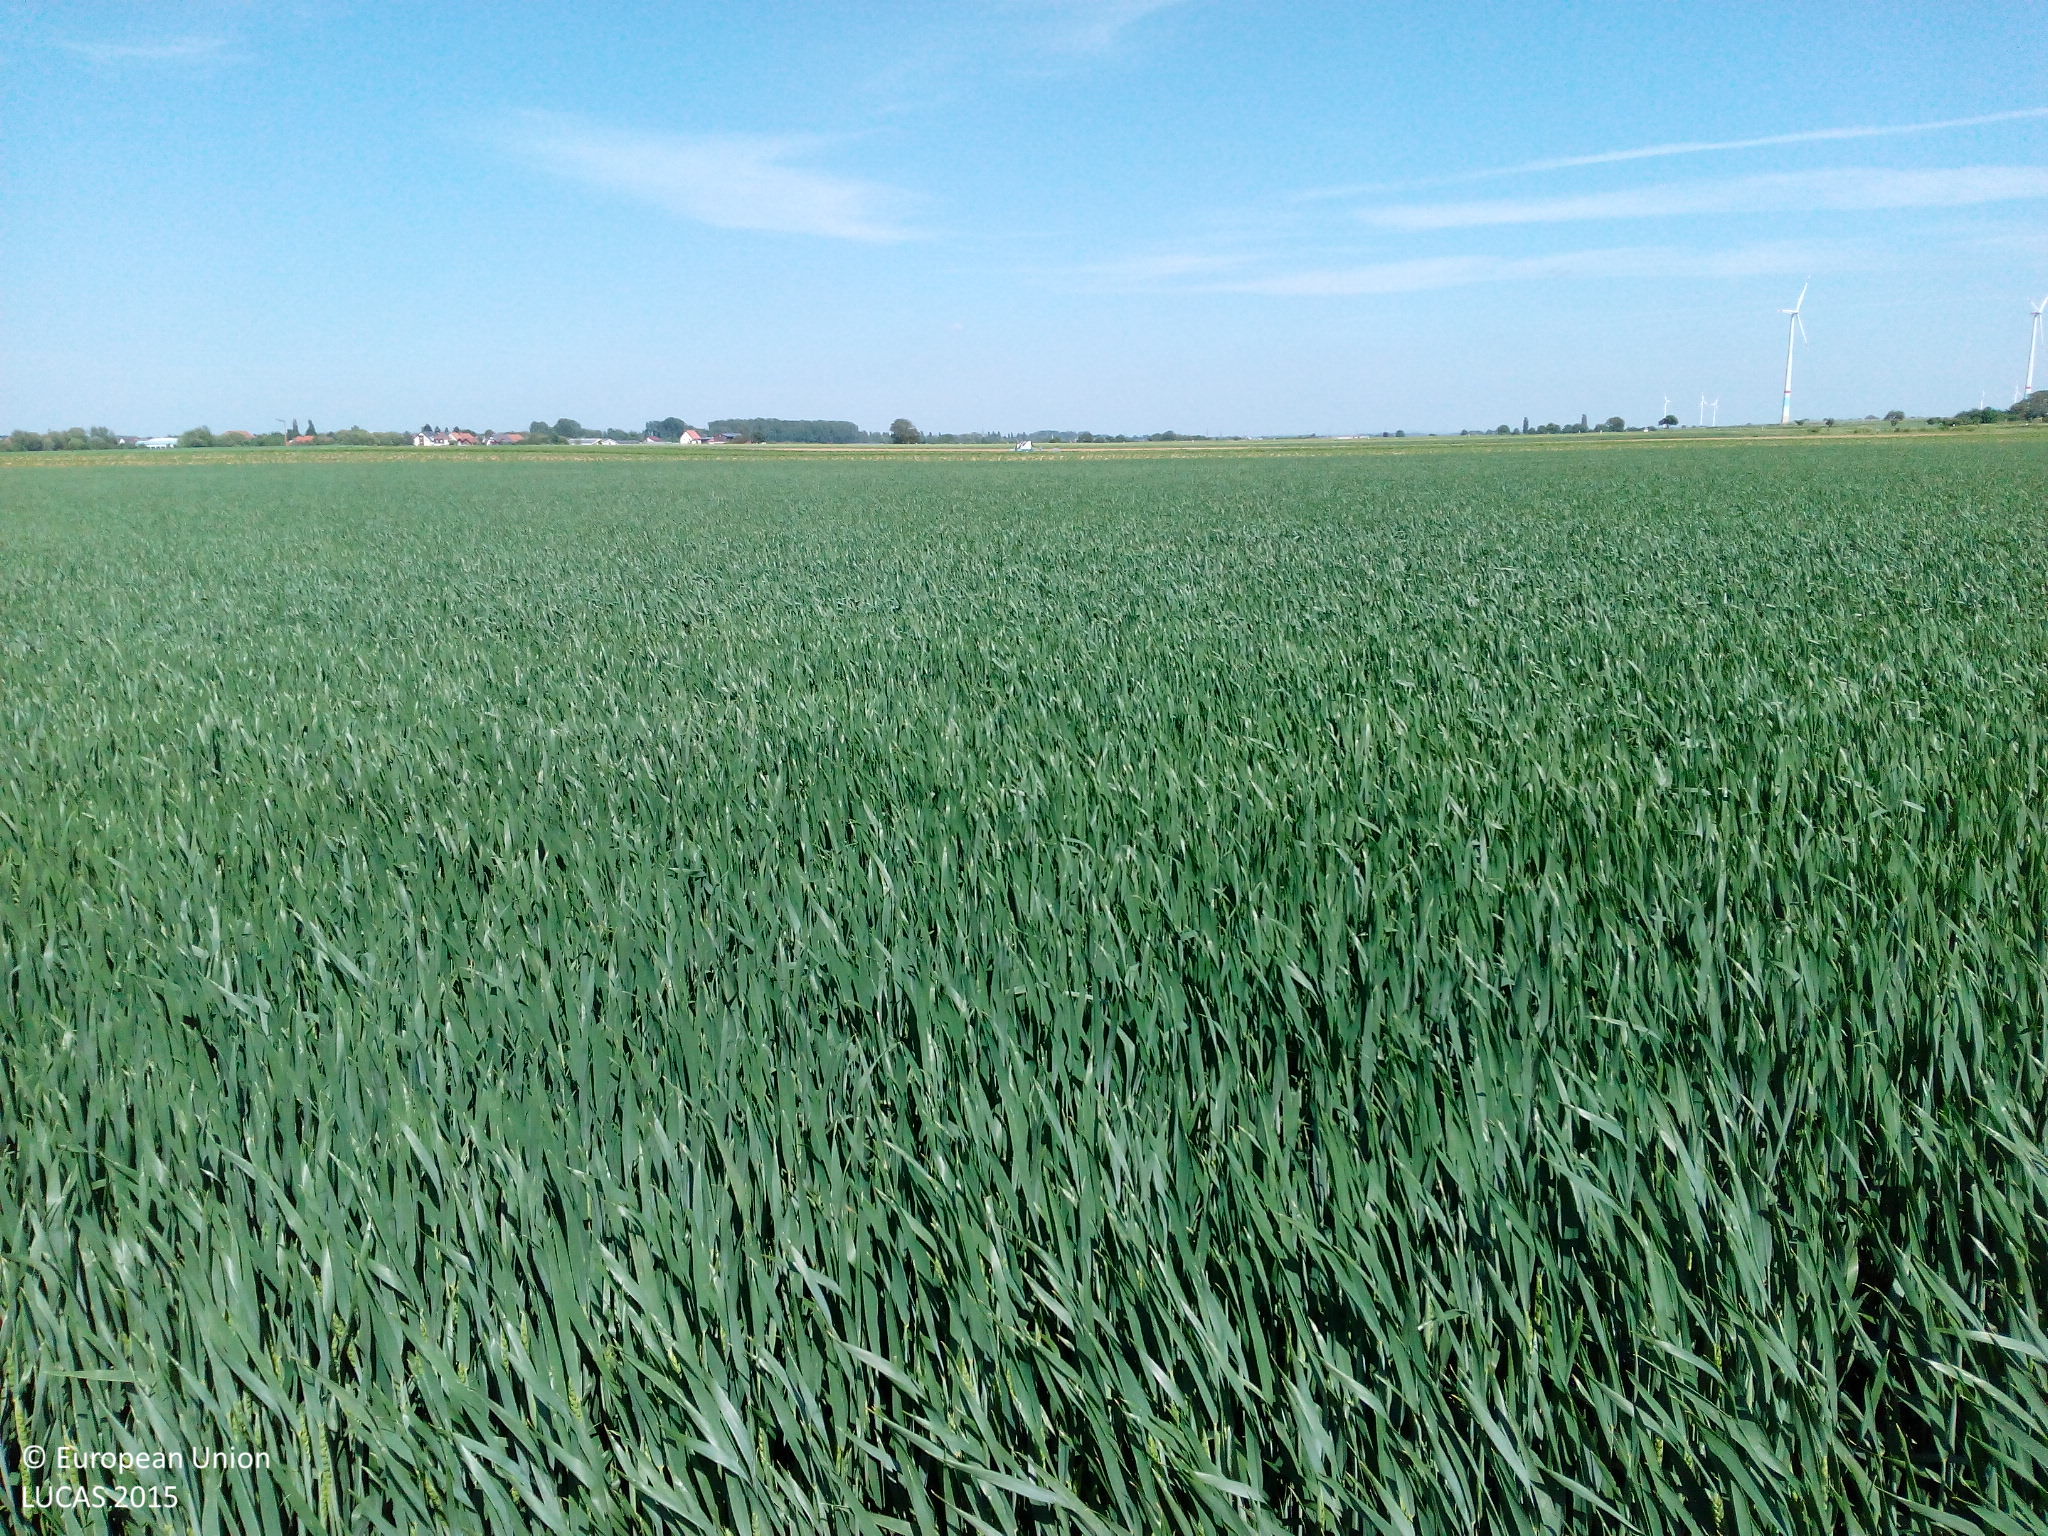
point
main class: Cropland
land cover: Common wheat
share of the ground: > 75 %
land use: Agriculture (excluding fallow land and kitchen gardens)
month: May
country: DE
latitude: 49.1802
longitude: 8.1760
